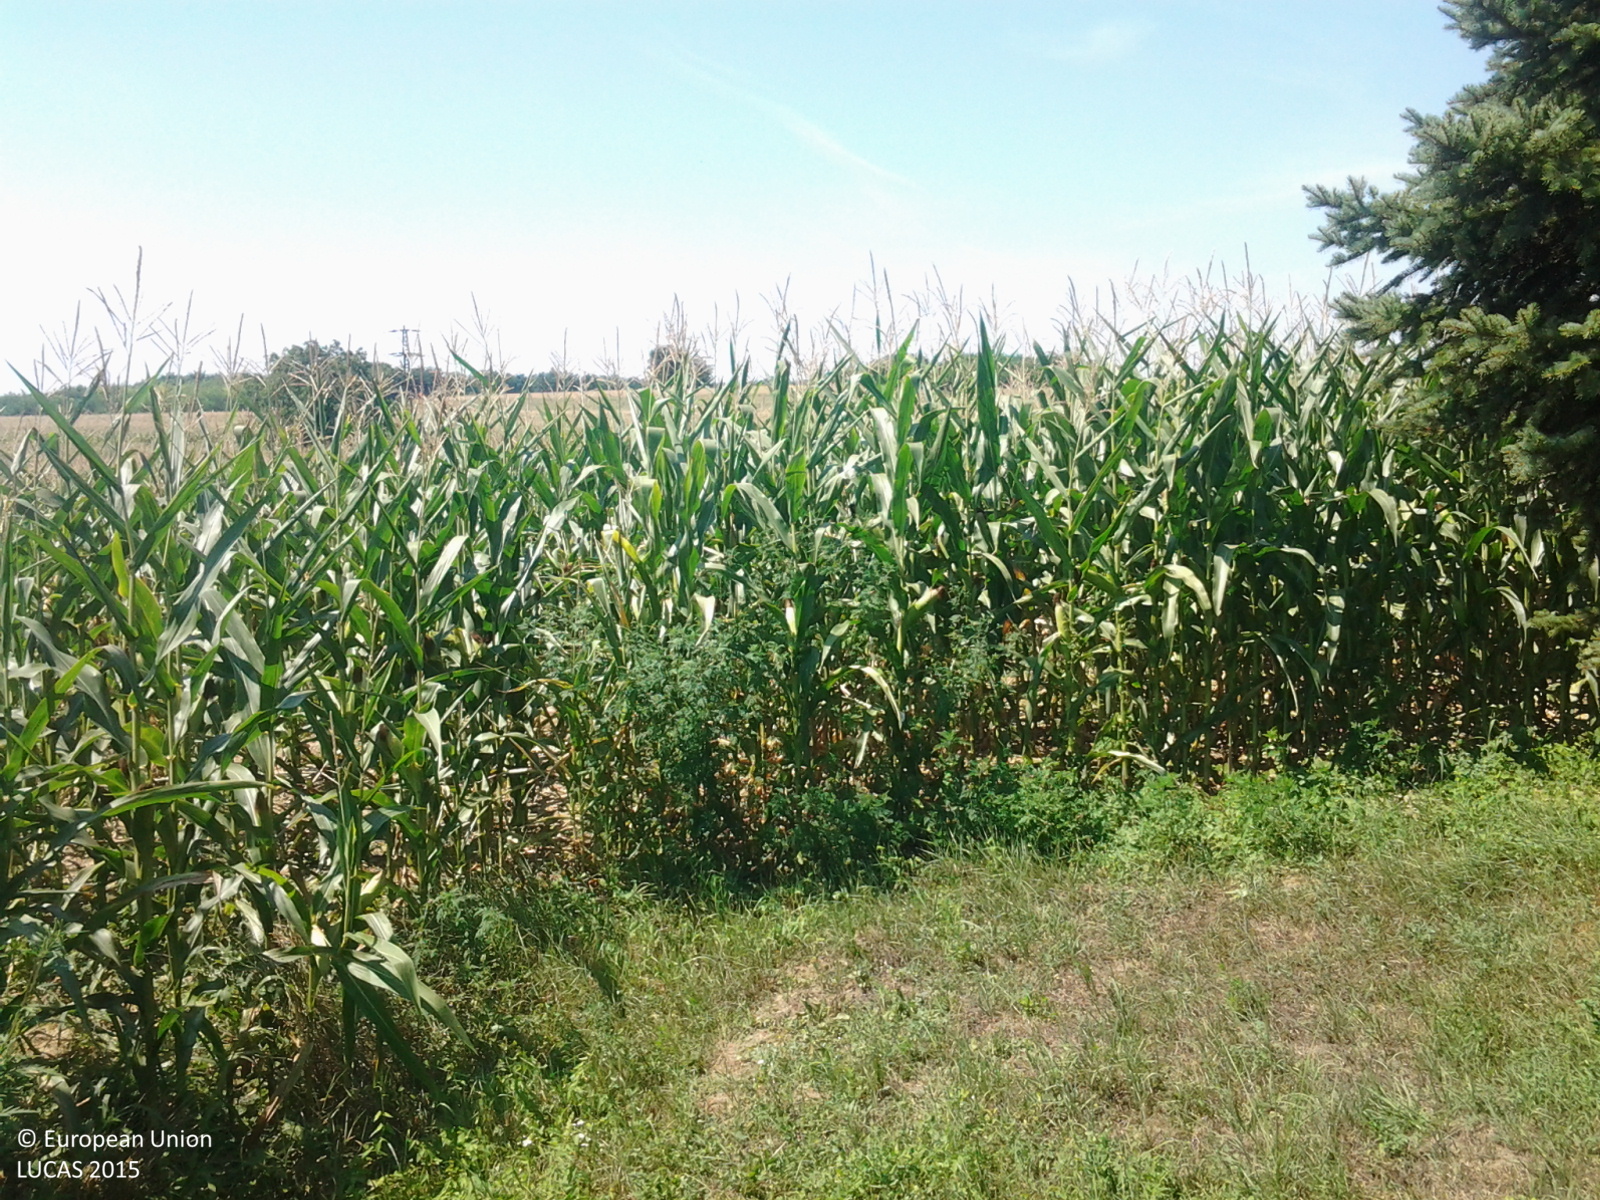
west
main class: Cropland
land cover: Maize
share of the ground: > 75 %
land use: Agriculture (excluding fallow land and kitchen gardens)
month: August
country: HU
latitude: 46.6020
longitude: 17.1184
